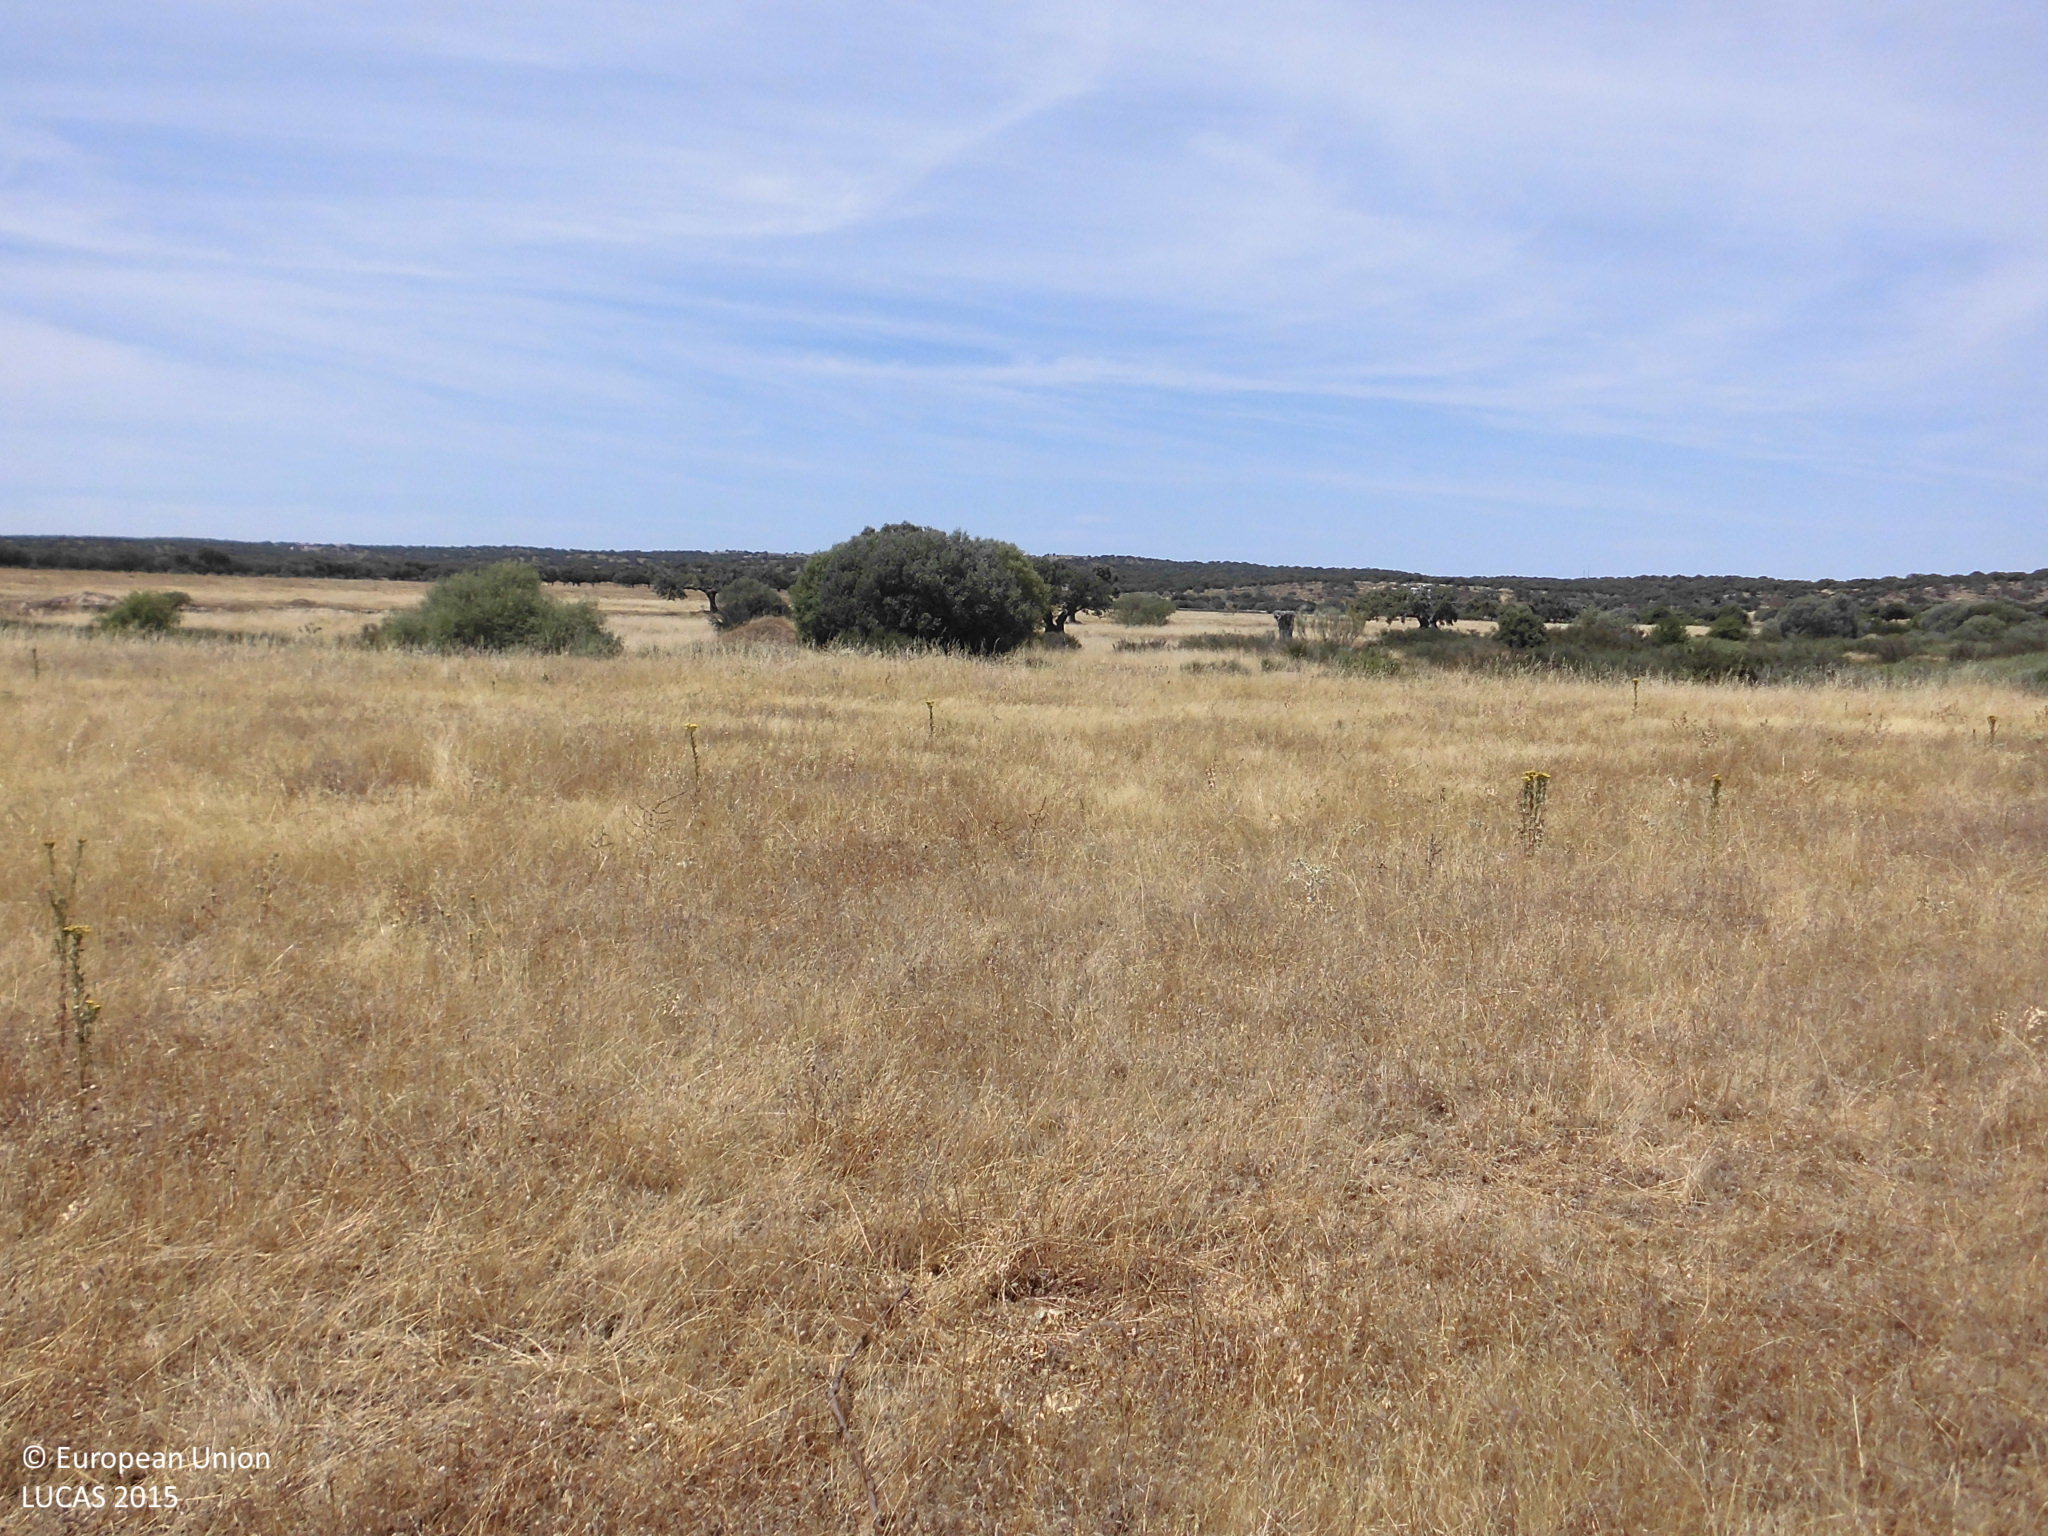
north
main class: Woodland
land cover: Broadleaved woodland
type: broadleaved evergreen forest
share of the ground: 10 - 25 %
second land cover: Grassland without tree/shrub cover
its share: > 75 %
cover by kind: herbaceous plants 90 %, broadleaved forest trees 10 %
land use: Forestry
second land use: Agriculture (excluding fallow land and kitchen gardens)
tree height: > 5 m
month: July
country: ES
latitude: 39.8817
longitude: -6.5542
